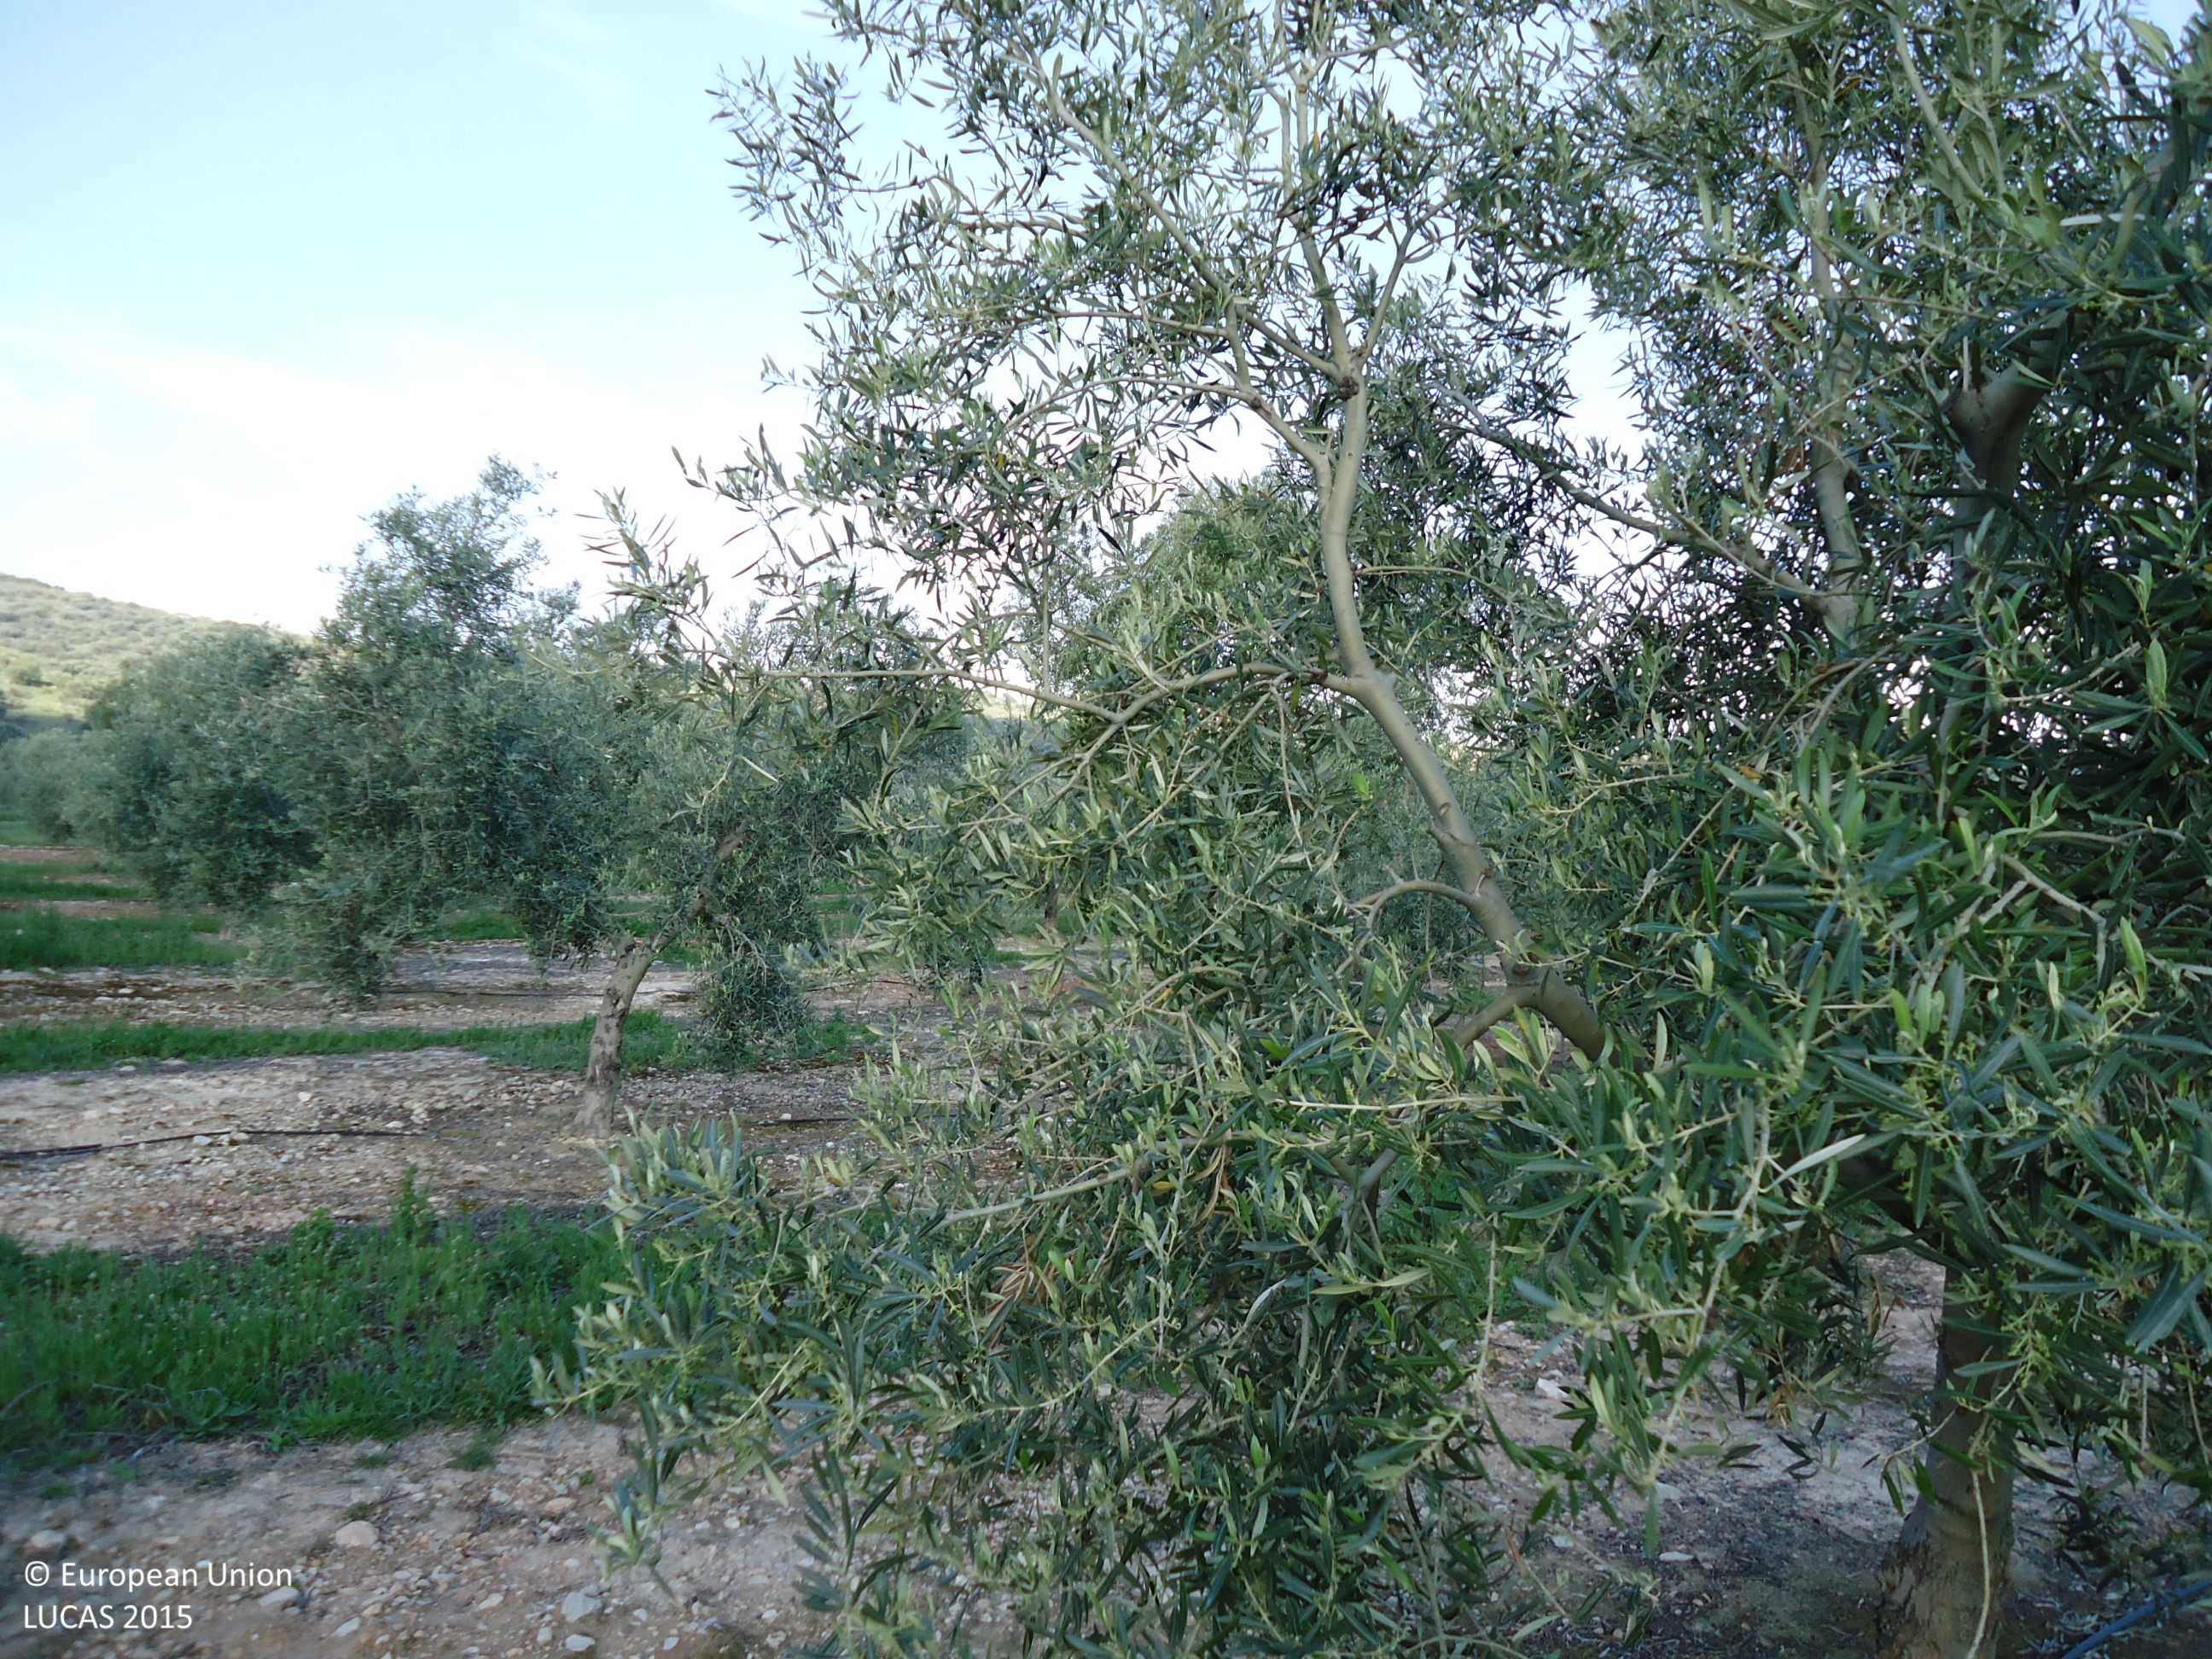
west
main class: Cropland
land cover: Olive groves
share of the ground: 25 - 50 %
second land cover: Spontaneously vegetated surfaces
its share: 50 - 75 %
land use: Agriculture (excluding fallow land and kitchen gardens)
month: April
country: ES
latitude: 37.1802
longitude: -4.8600
